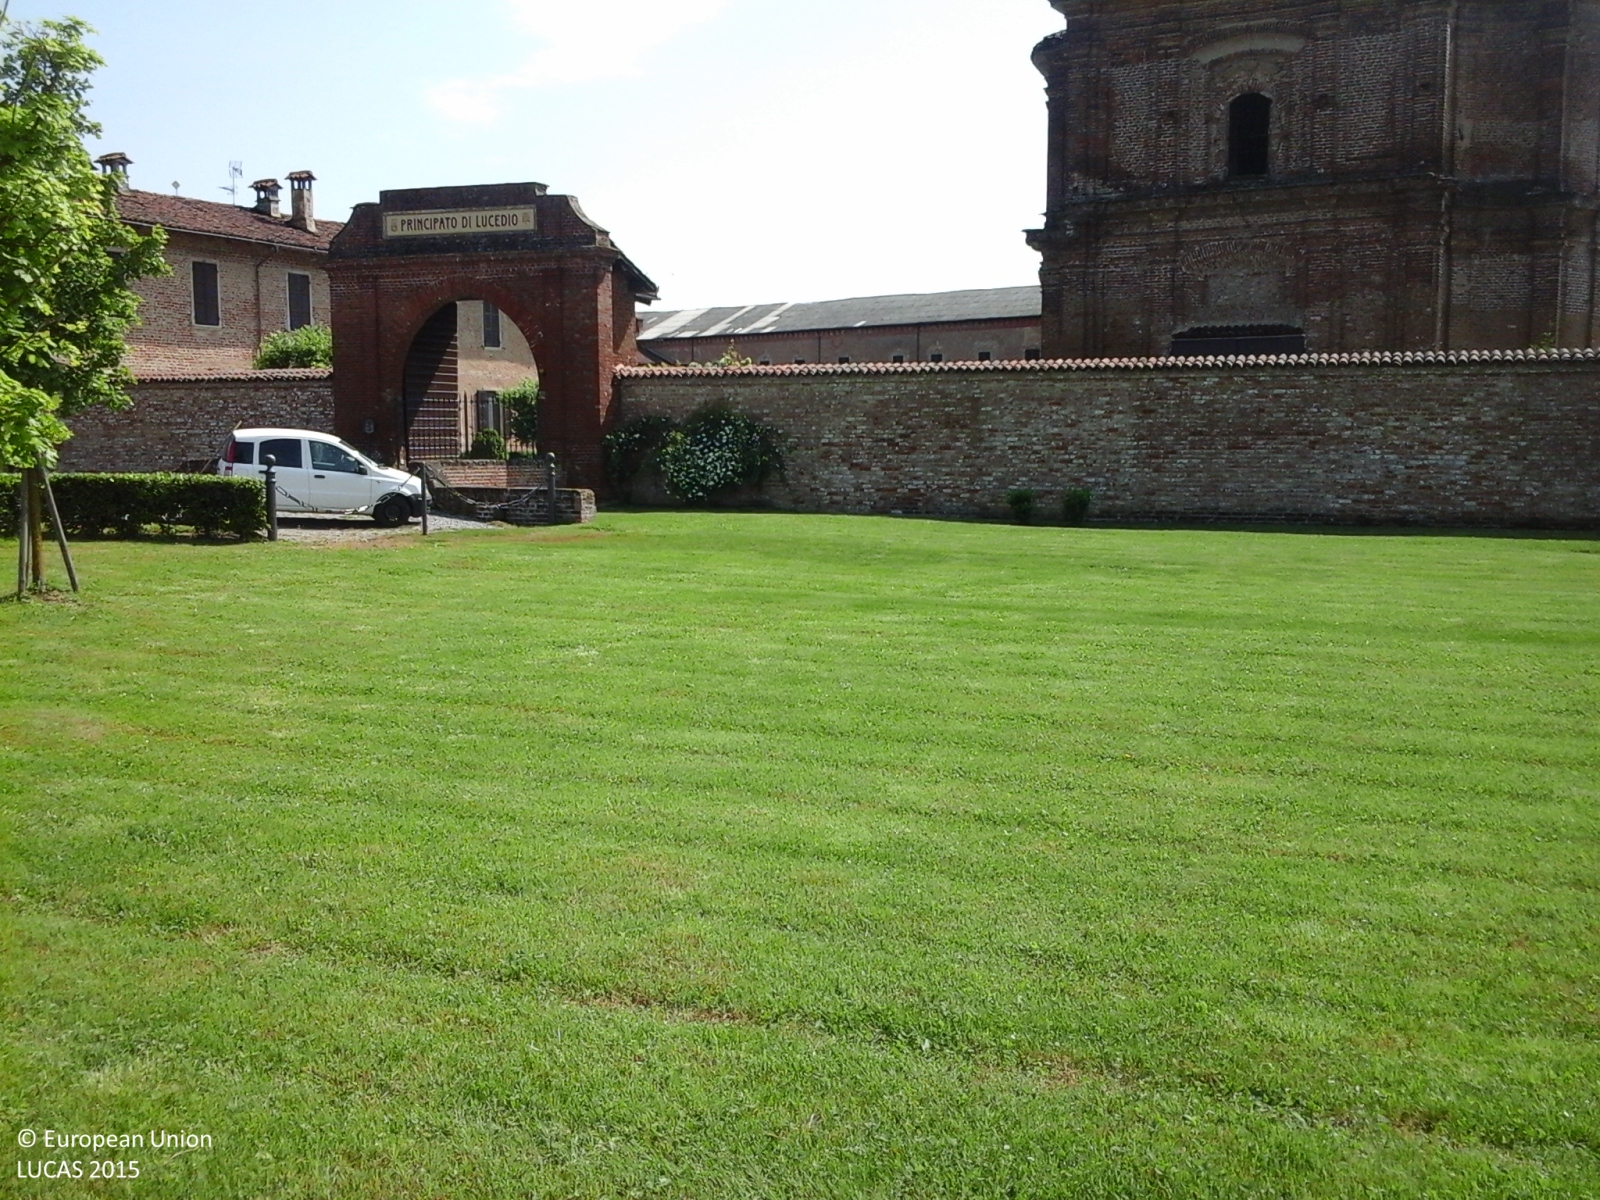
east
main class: Grassland
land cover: Grassland with sparse tree/shrub cover
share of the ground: > 75 %
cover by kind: herbaceous plants 95 %, broadleaved forest trees 5 %
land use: Community services
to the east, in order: Grassland with sparse tree/shrub cover; Artificial constructions in urban areas; Grassland without tree/shrub cover; Rice
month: May
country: IT
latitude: 45.2372
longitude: 8.2324
